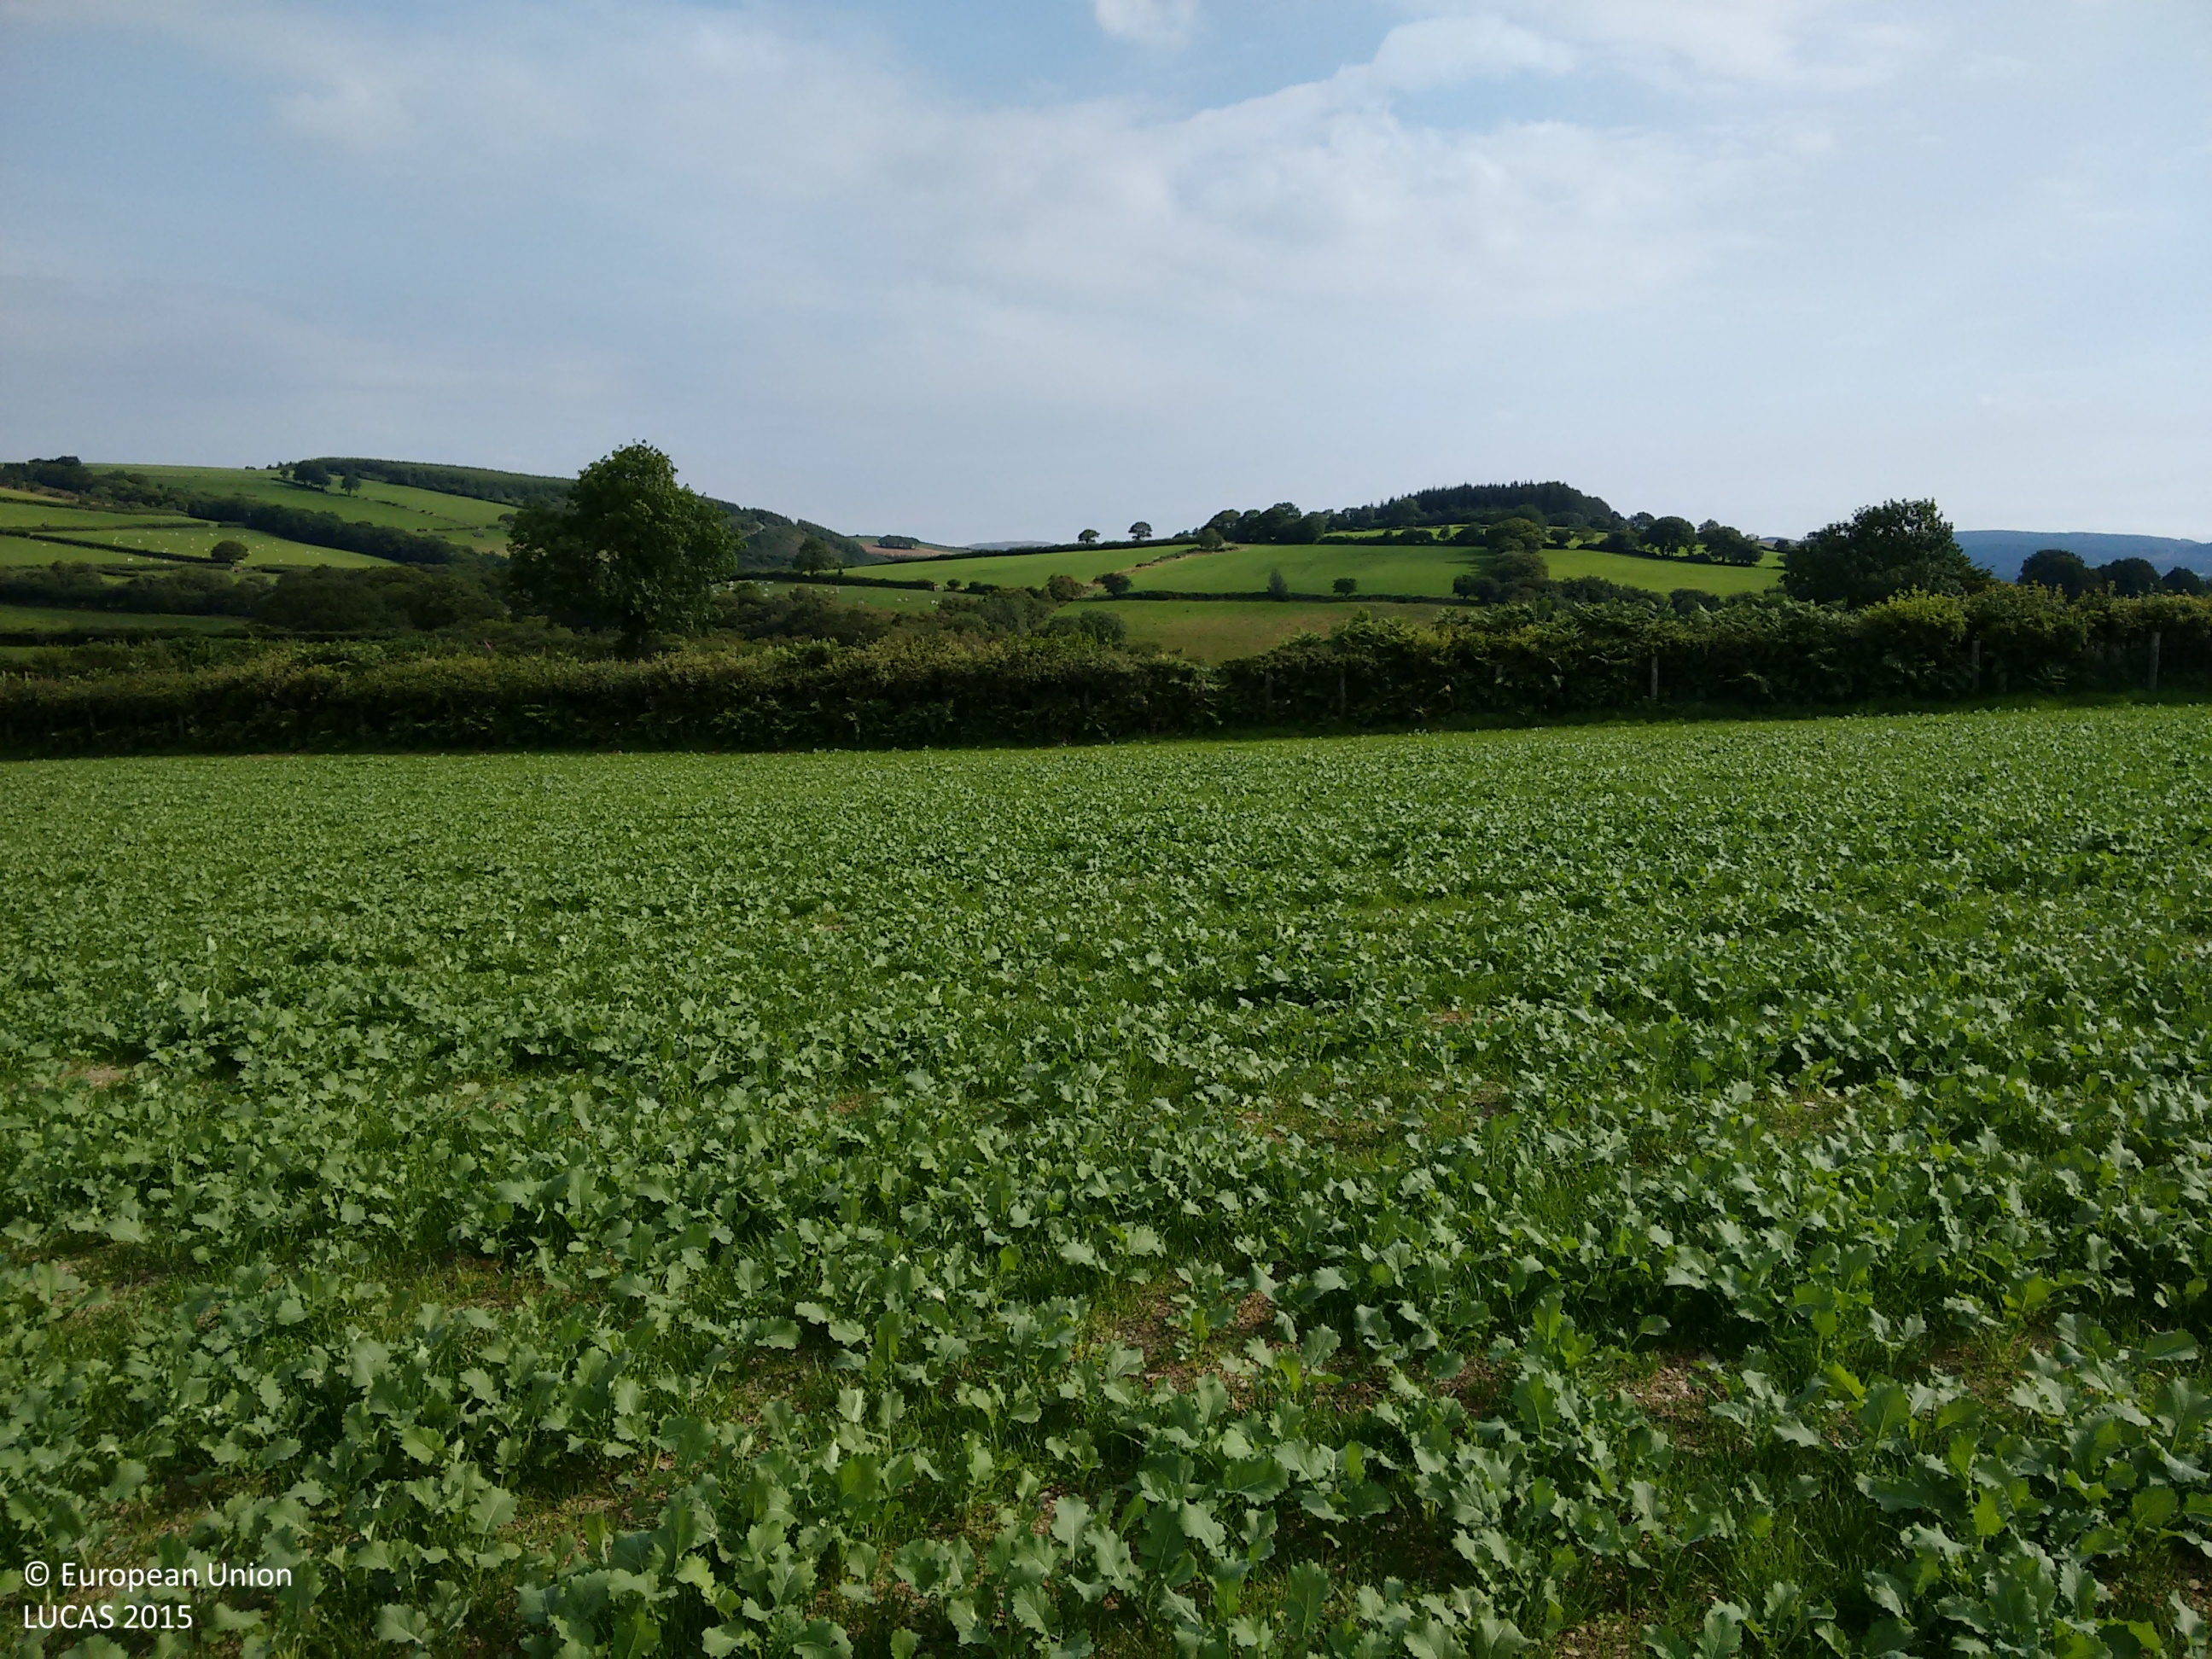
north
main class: Cropland
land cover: Sugar beet
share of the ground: > 75 %
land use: Agriculture (excluding fallow land and kitchen gardens)
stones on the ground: 10 - 25 %
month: August
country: GB
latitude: 52.0158
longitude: -4.0101
